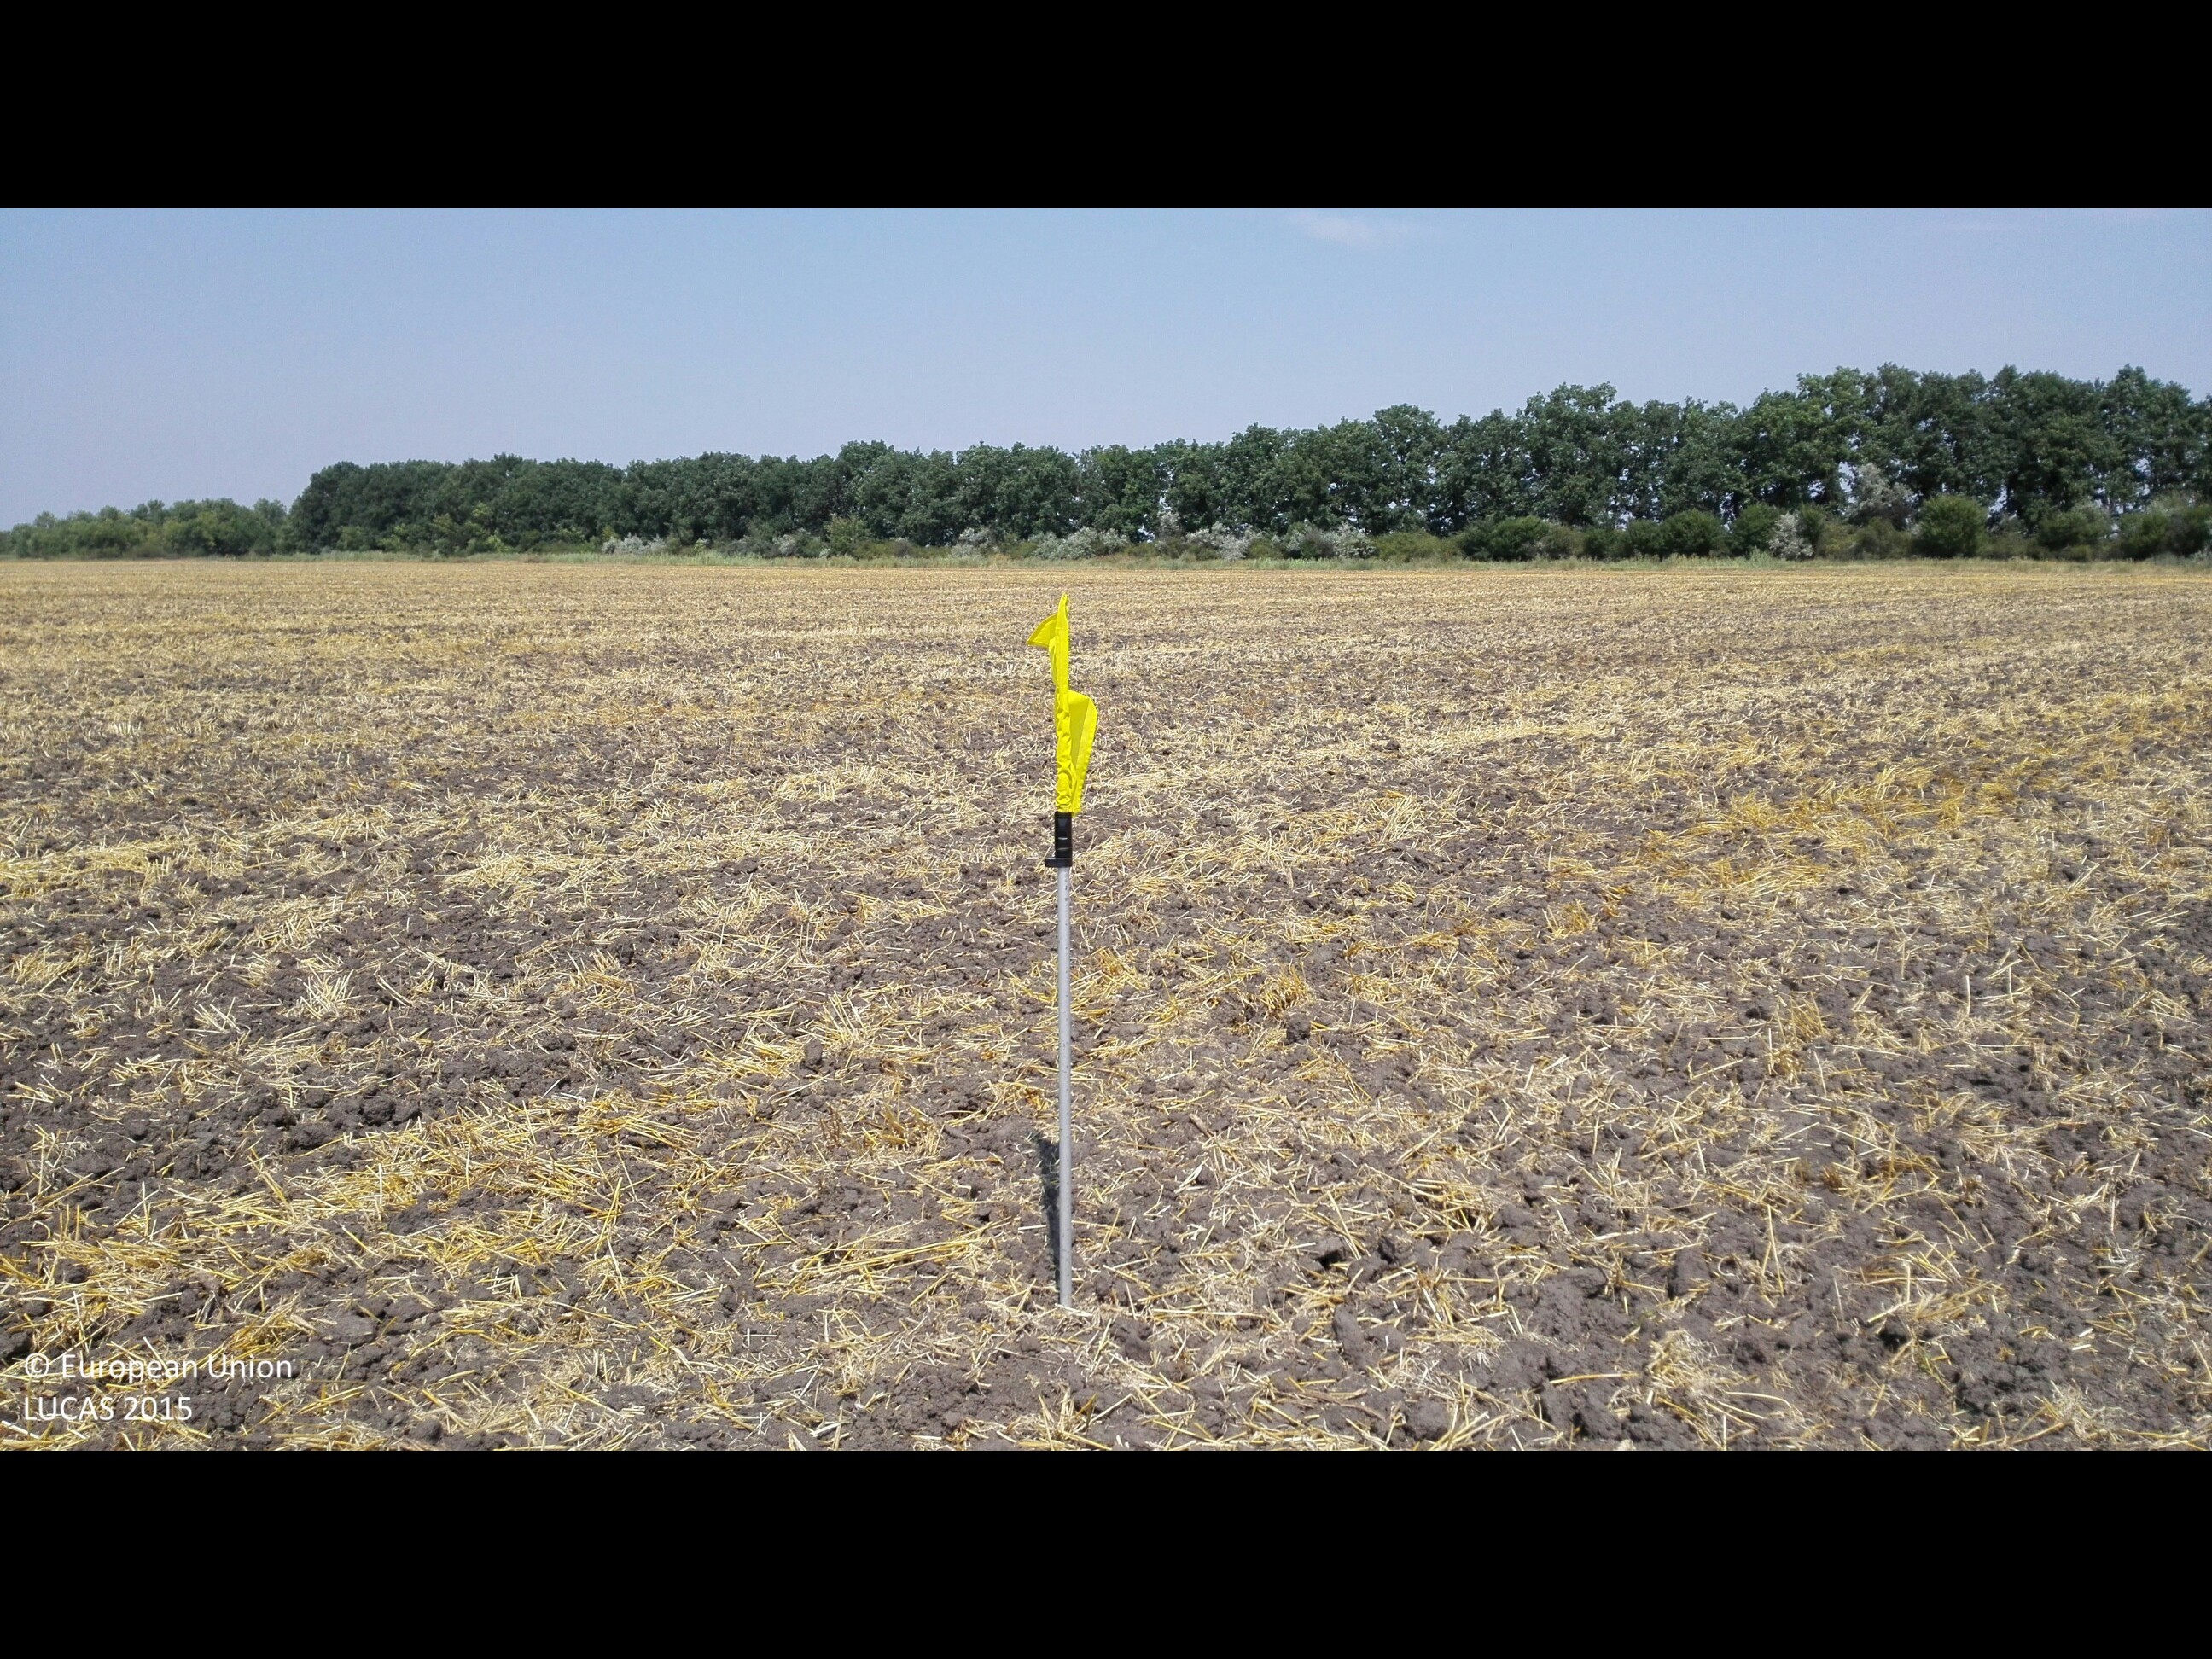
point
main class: Cropland
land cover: Common wheat
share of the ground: > 75 %
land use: Agriculture (excluding fallow land and kitchen gardens)
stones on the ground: < 10 %
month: July
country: HU
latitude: 47.1921
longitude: 21.2436
